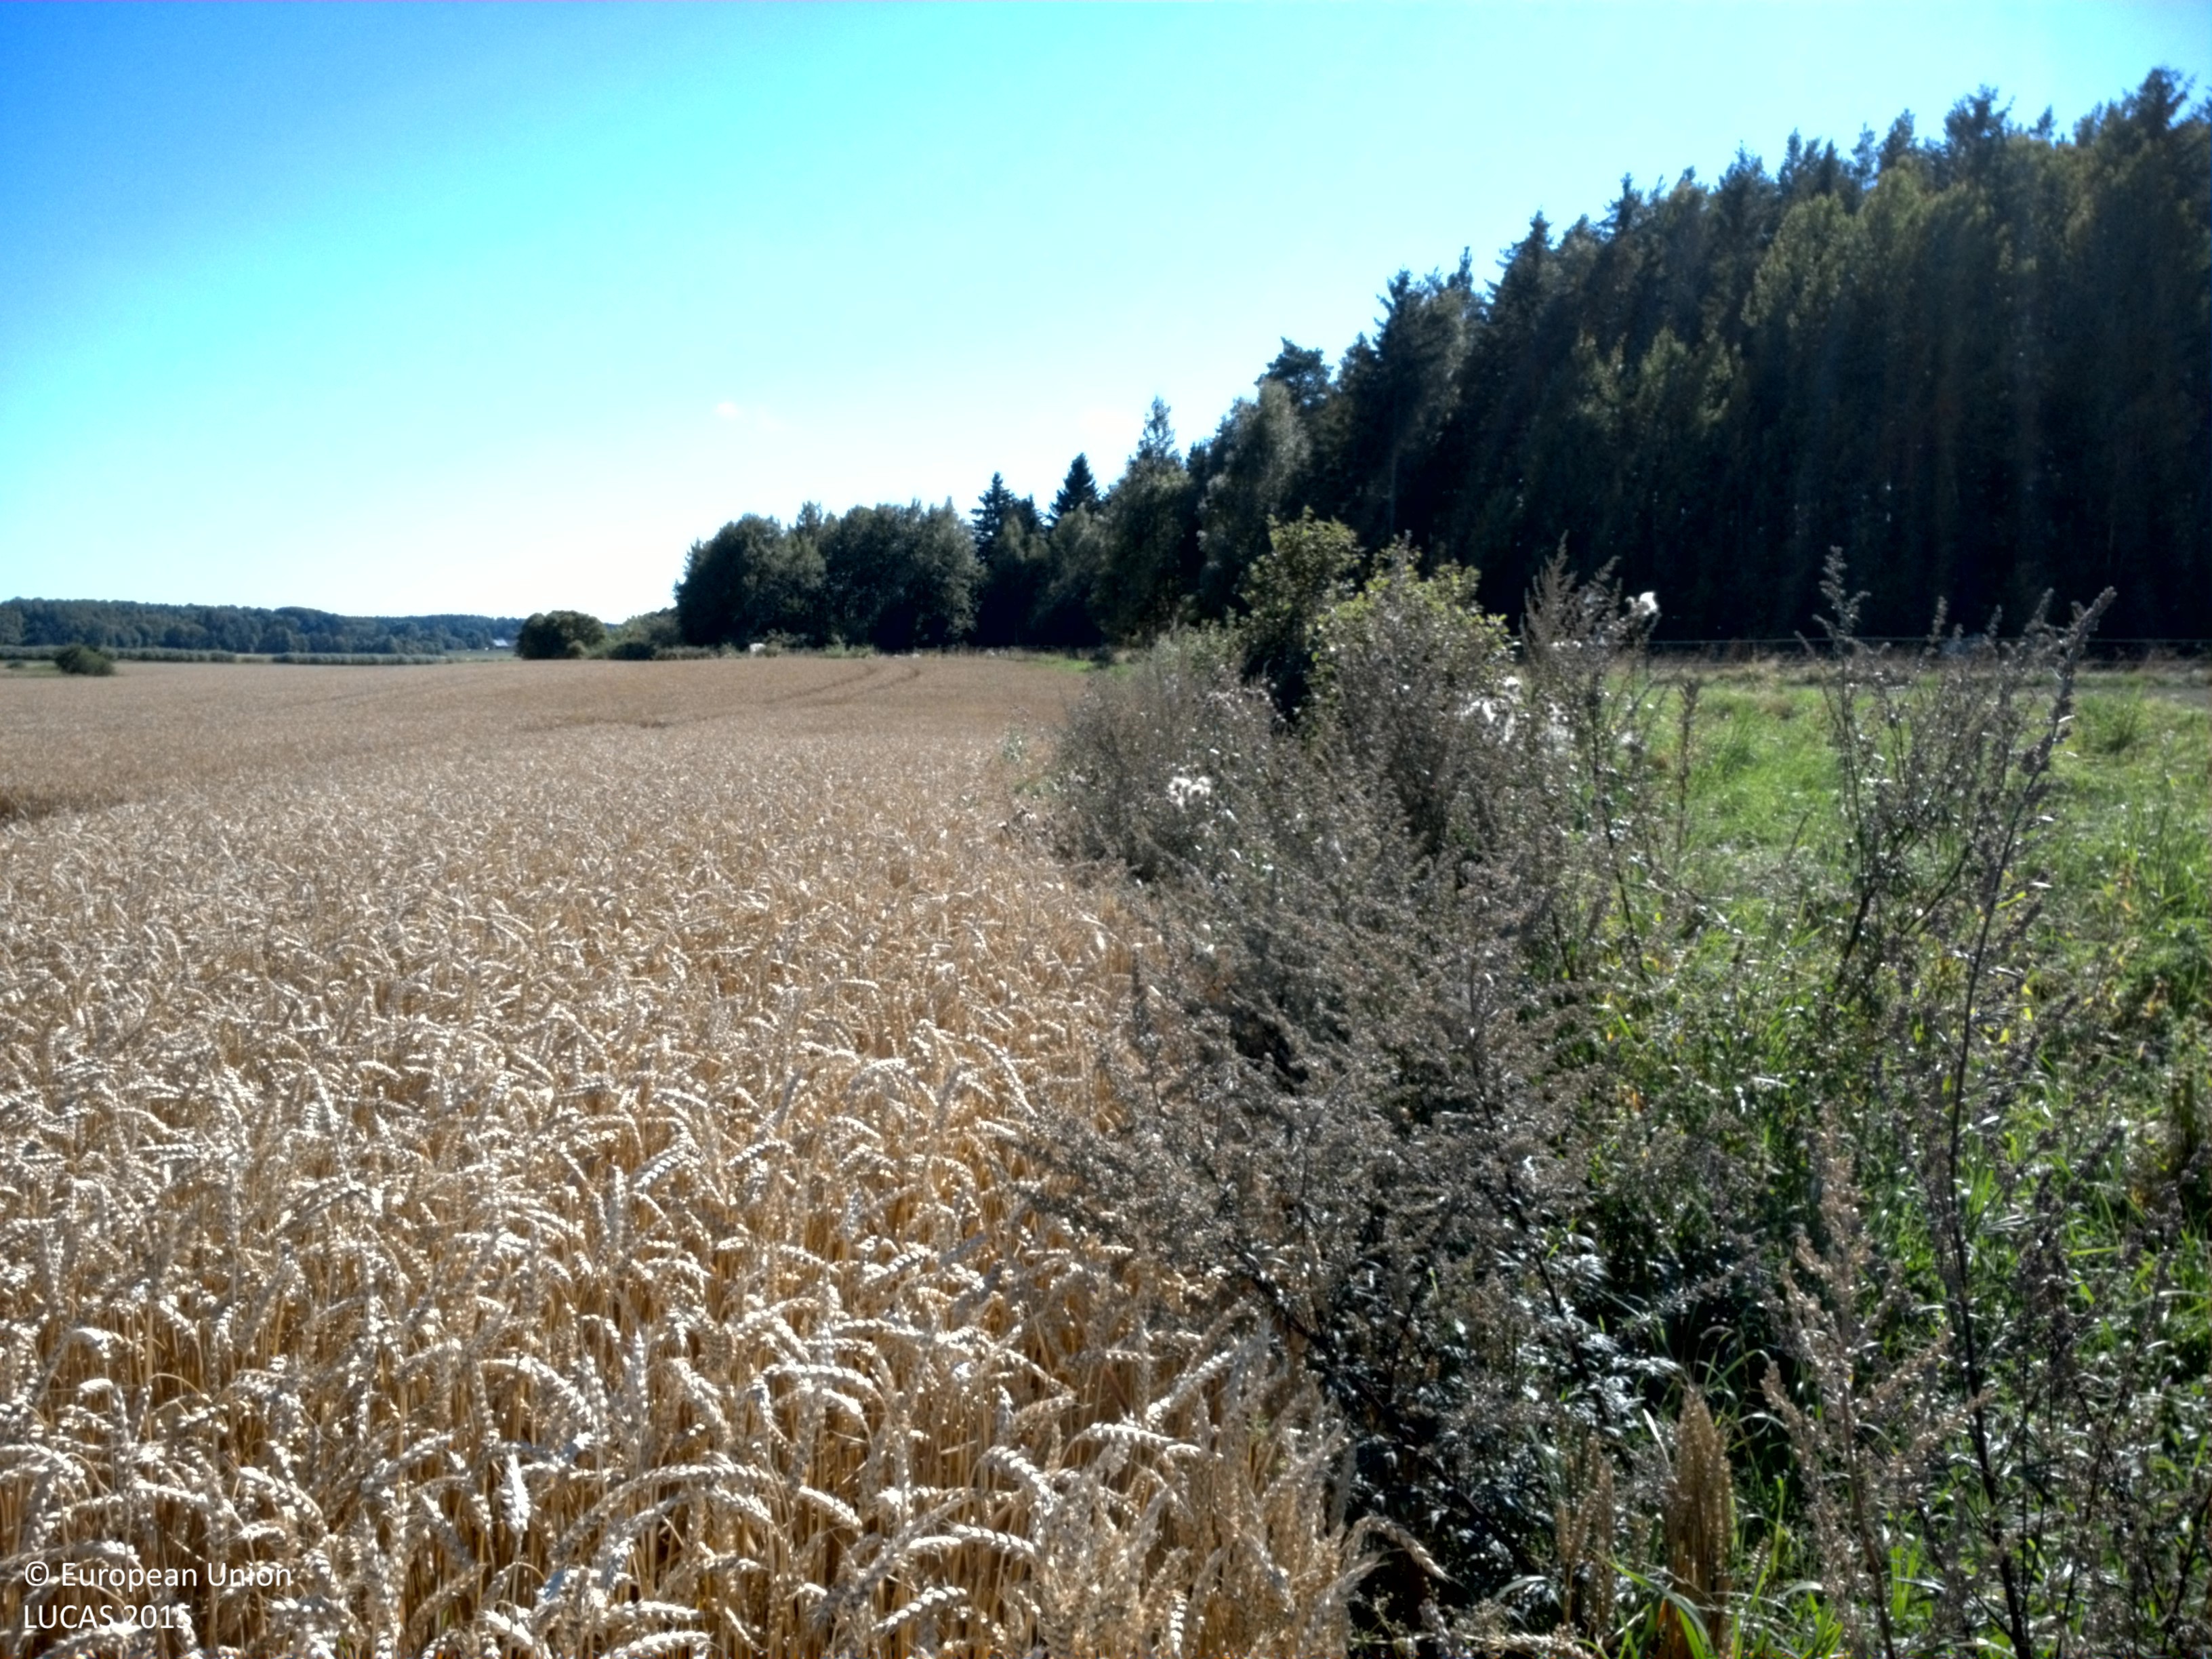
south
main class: Cropland
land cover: Common wheat
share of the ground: > 75 %
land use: Agriculture (excluding fallow land and kitchen gardens)
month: August
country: SE
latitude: 59.7230
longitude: 17.5876
